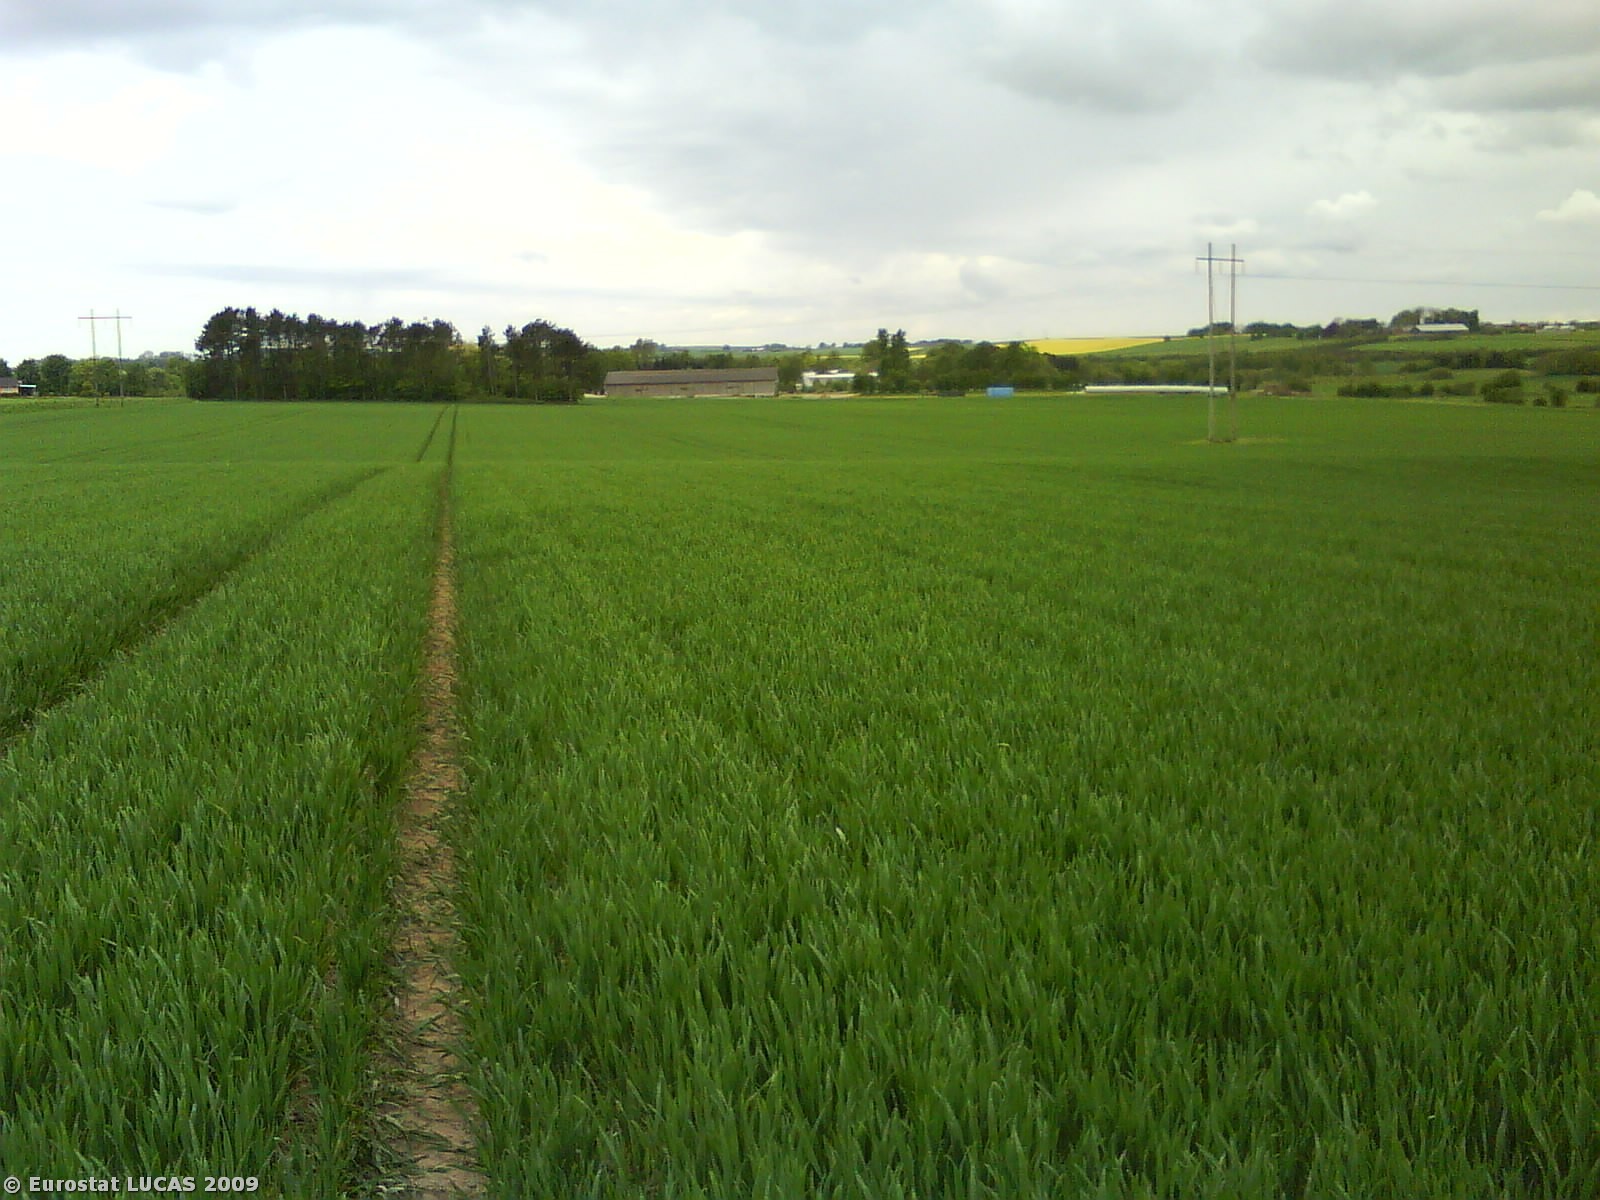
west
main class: Cropland
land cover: Common wheat
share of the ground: > 75 %
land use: Agriculture (excluding fallow land and kitchen gardens)
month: May
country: DK
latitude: 56.4212
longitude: 10.2429
